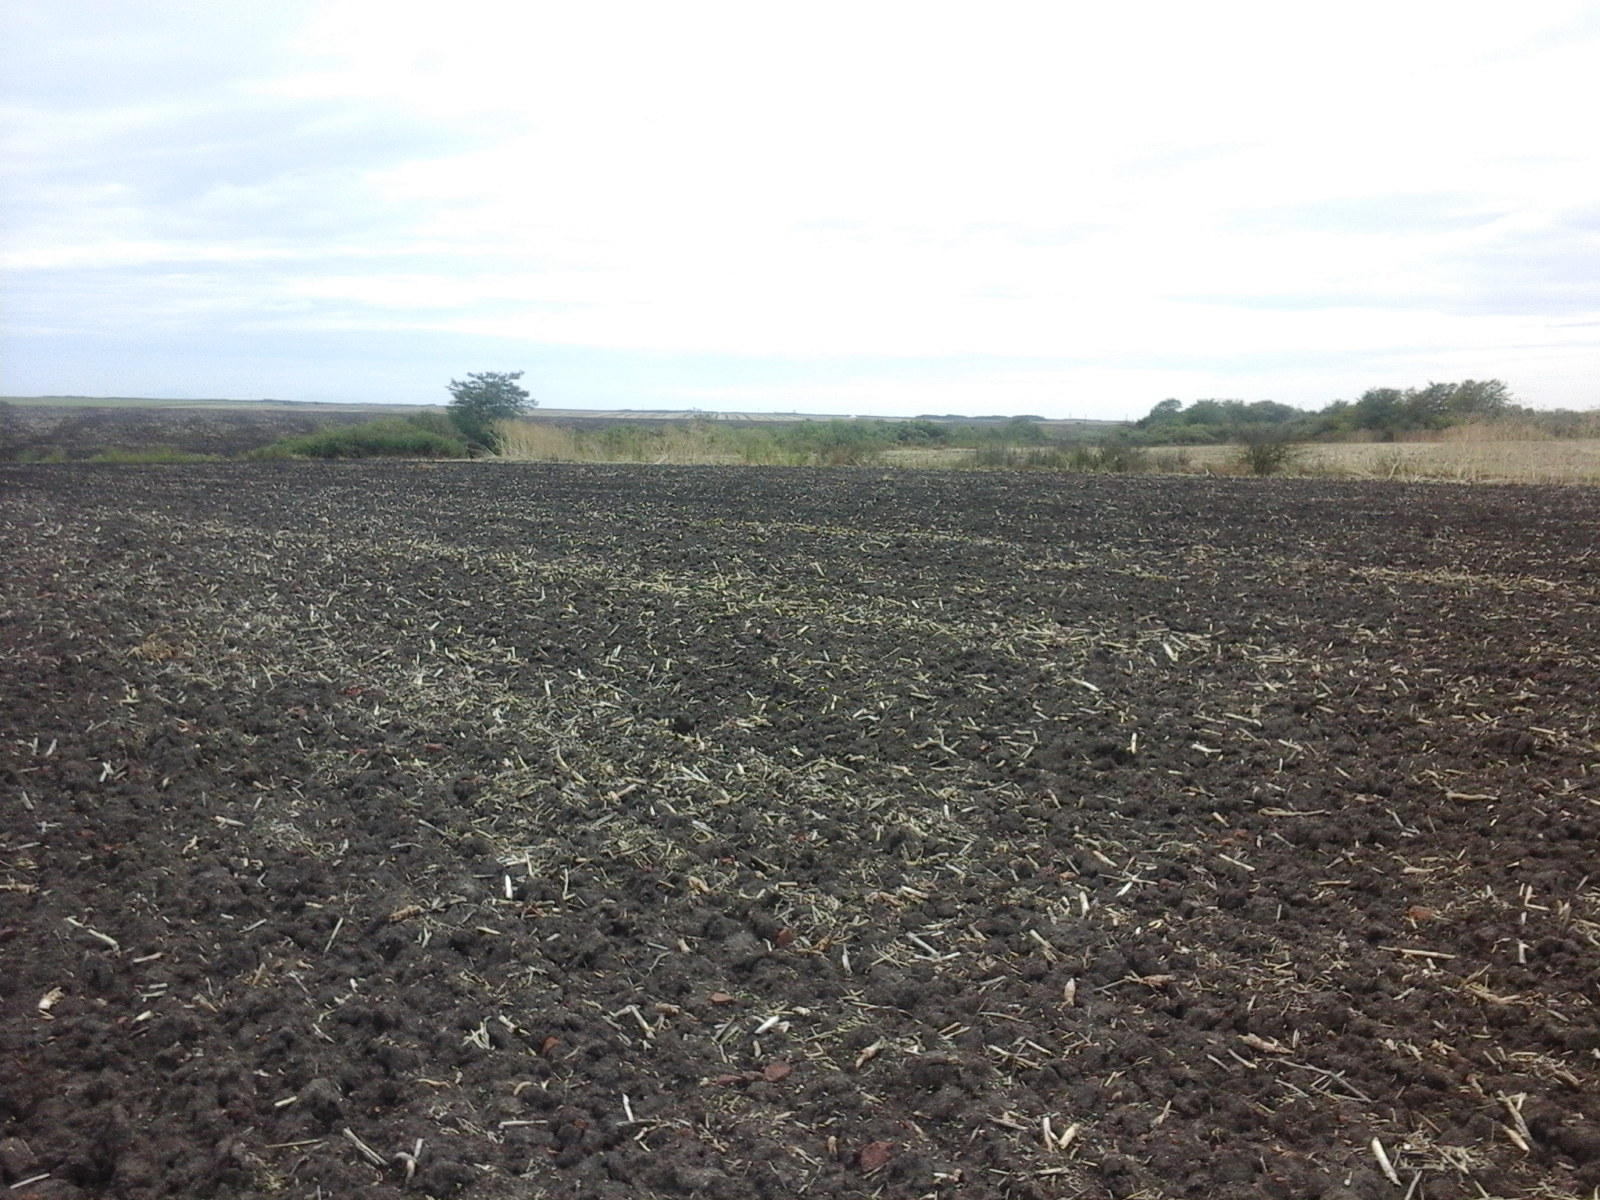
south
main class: Cropland
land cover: Rape and turnip rape
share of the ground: < 10 %
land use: Agriculture (excluding fallow land and kitchen gardens)
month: August
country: RO
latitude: 45.5104
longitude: 21.3328
